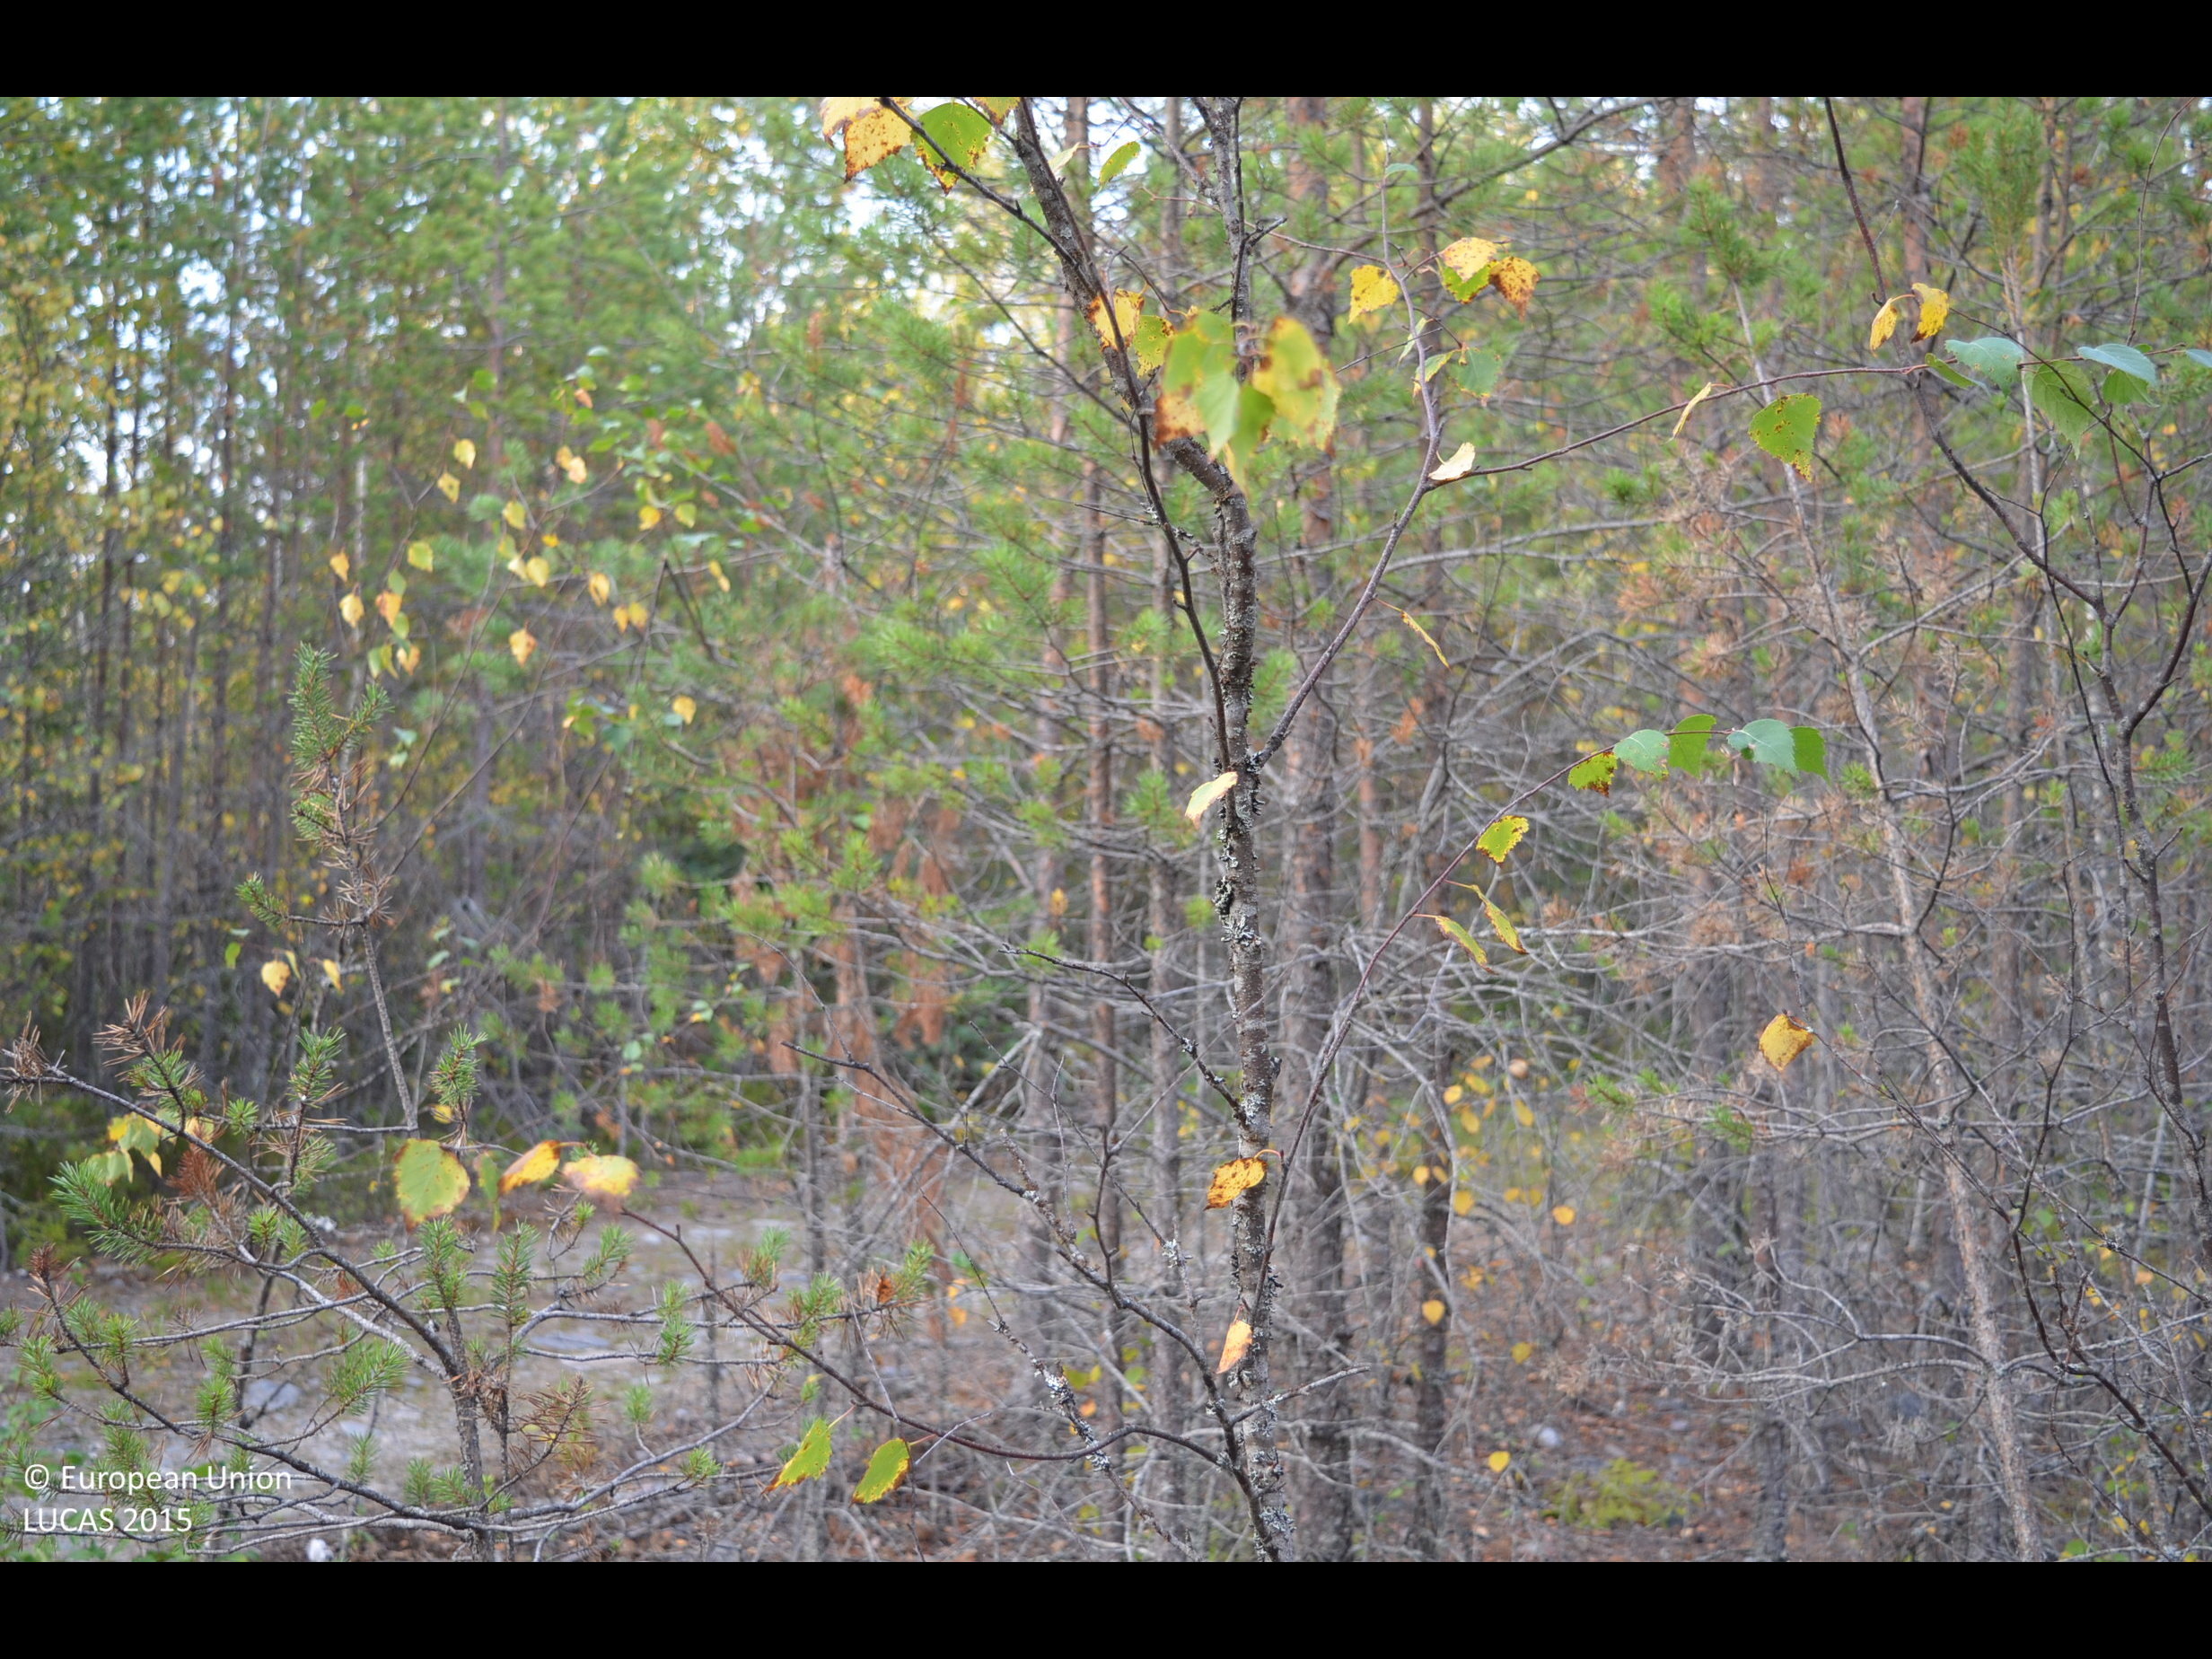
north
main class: Woodland
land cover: Pine dominated coniferous woodland
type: boreal forest
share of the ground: 50 - 75 %
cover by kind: coniferous forest trees 50 %, broadleaved forest trees 15 %, lichens and mosses 10 %, consolidated bare surface 10 %, shrubs 5 %
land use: Forestry
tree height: > 5 m
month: September
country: FI
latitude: 63.0440
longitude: 23.7336
